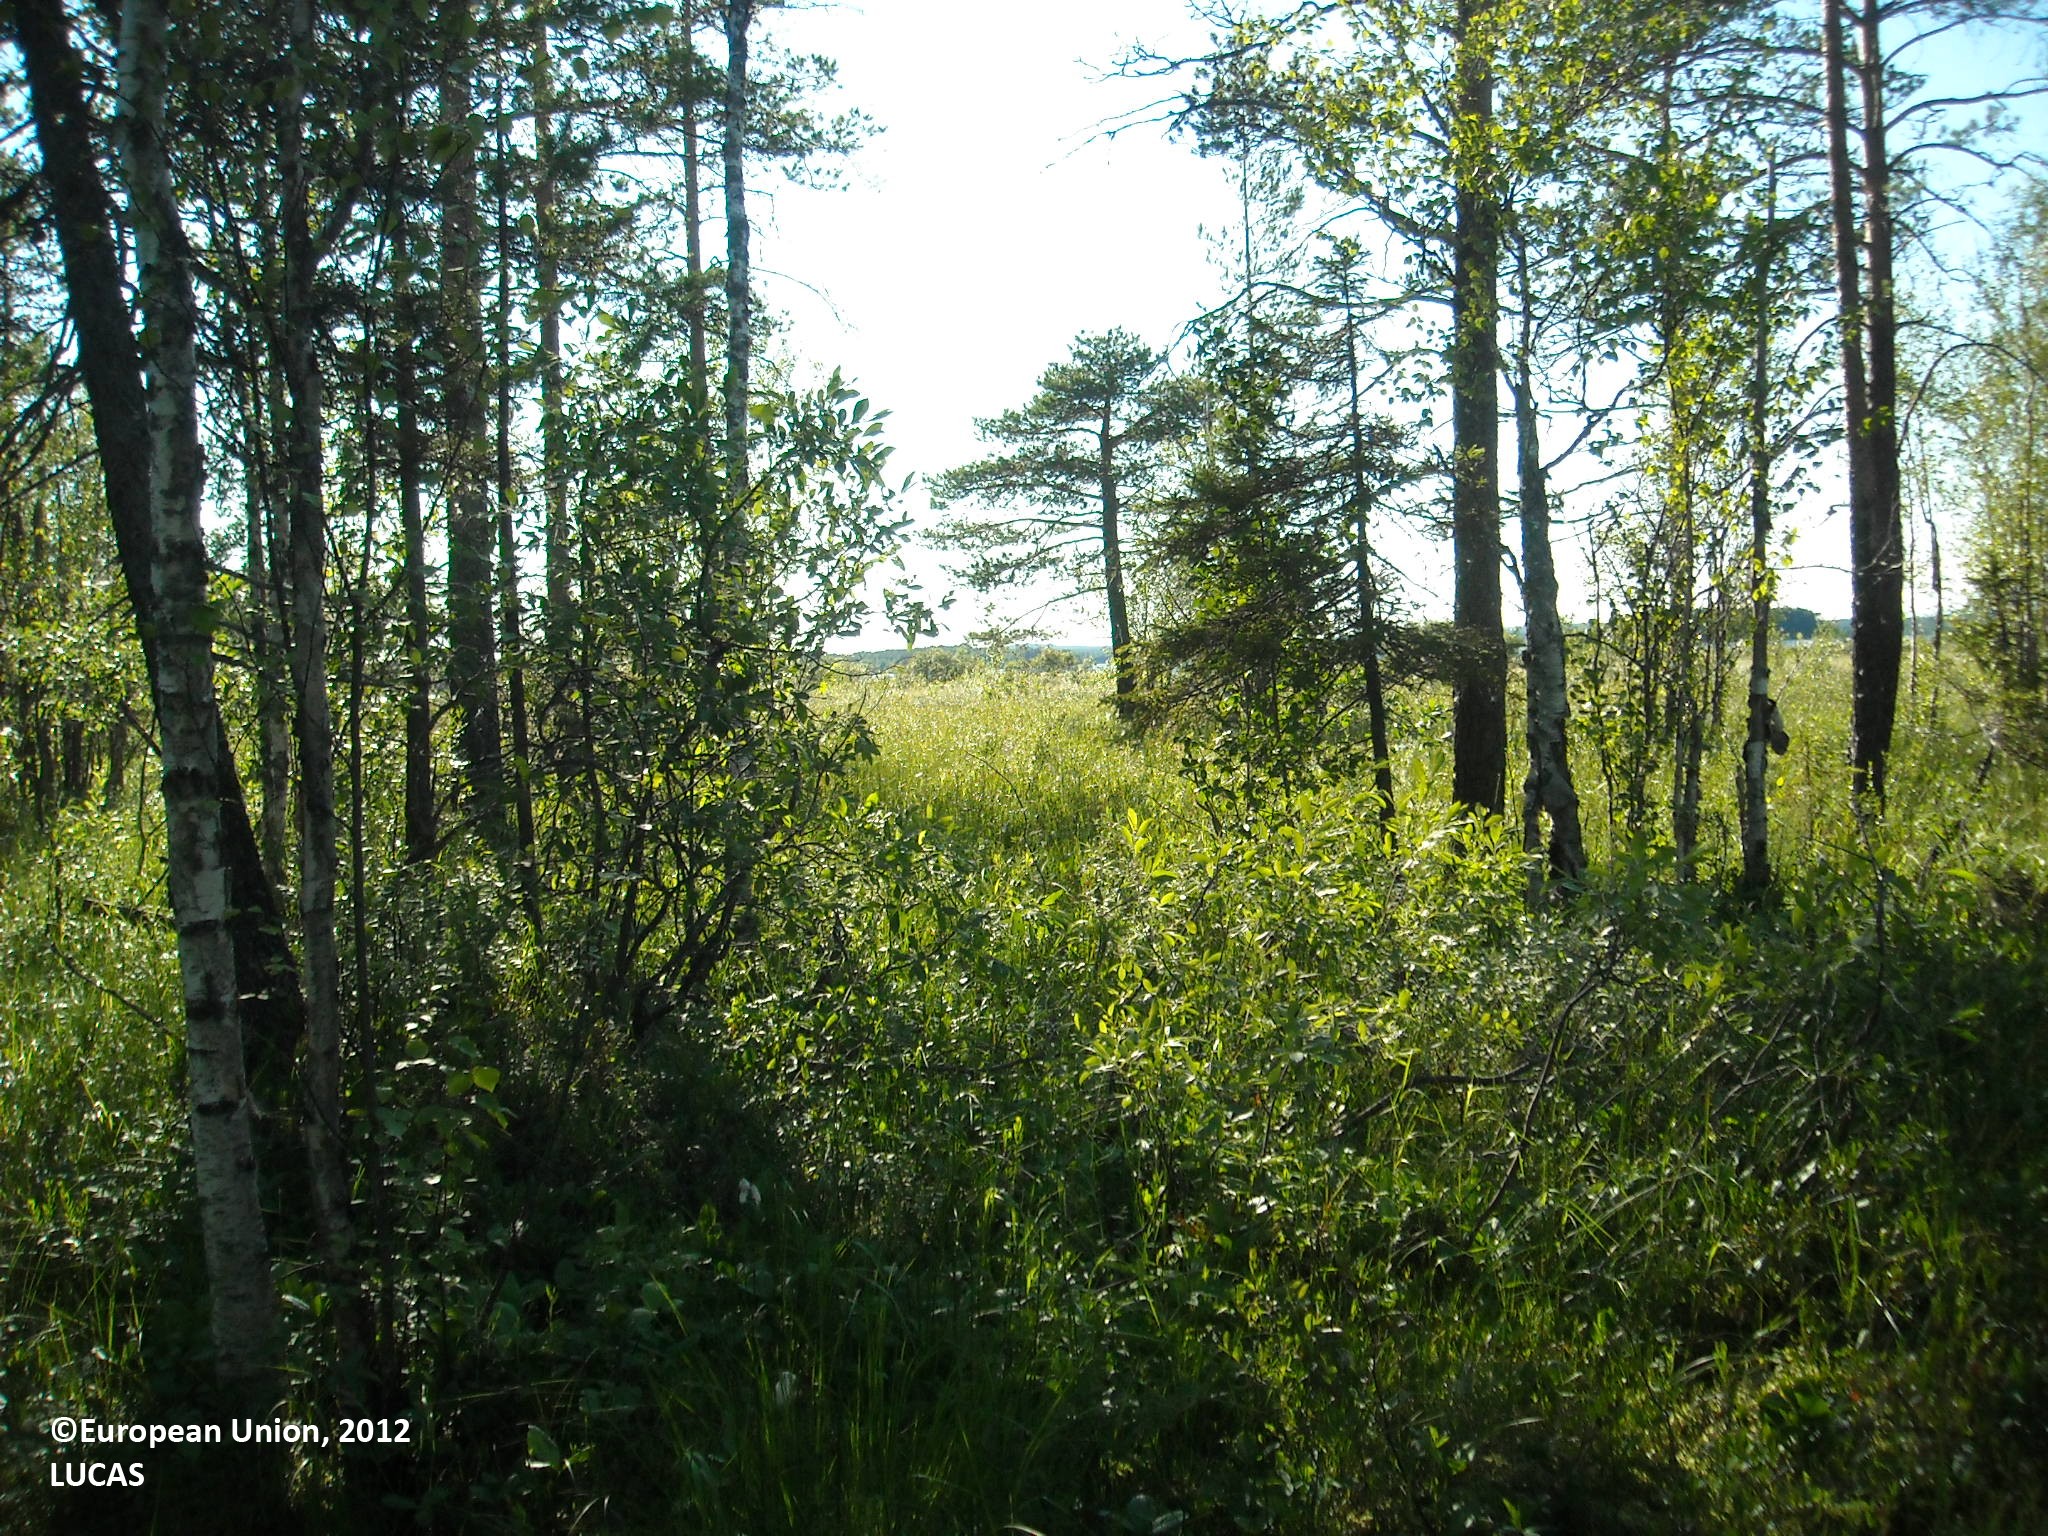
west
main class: Woodland
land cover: Broadleaved woodland
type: mire and swamp forests
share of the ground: 50 - 75 %
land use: Semi-natural and natural areas not in use
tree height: > 5 m
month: July
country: FI
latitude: 65.1603
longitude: 27.6985
